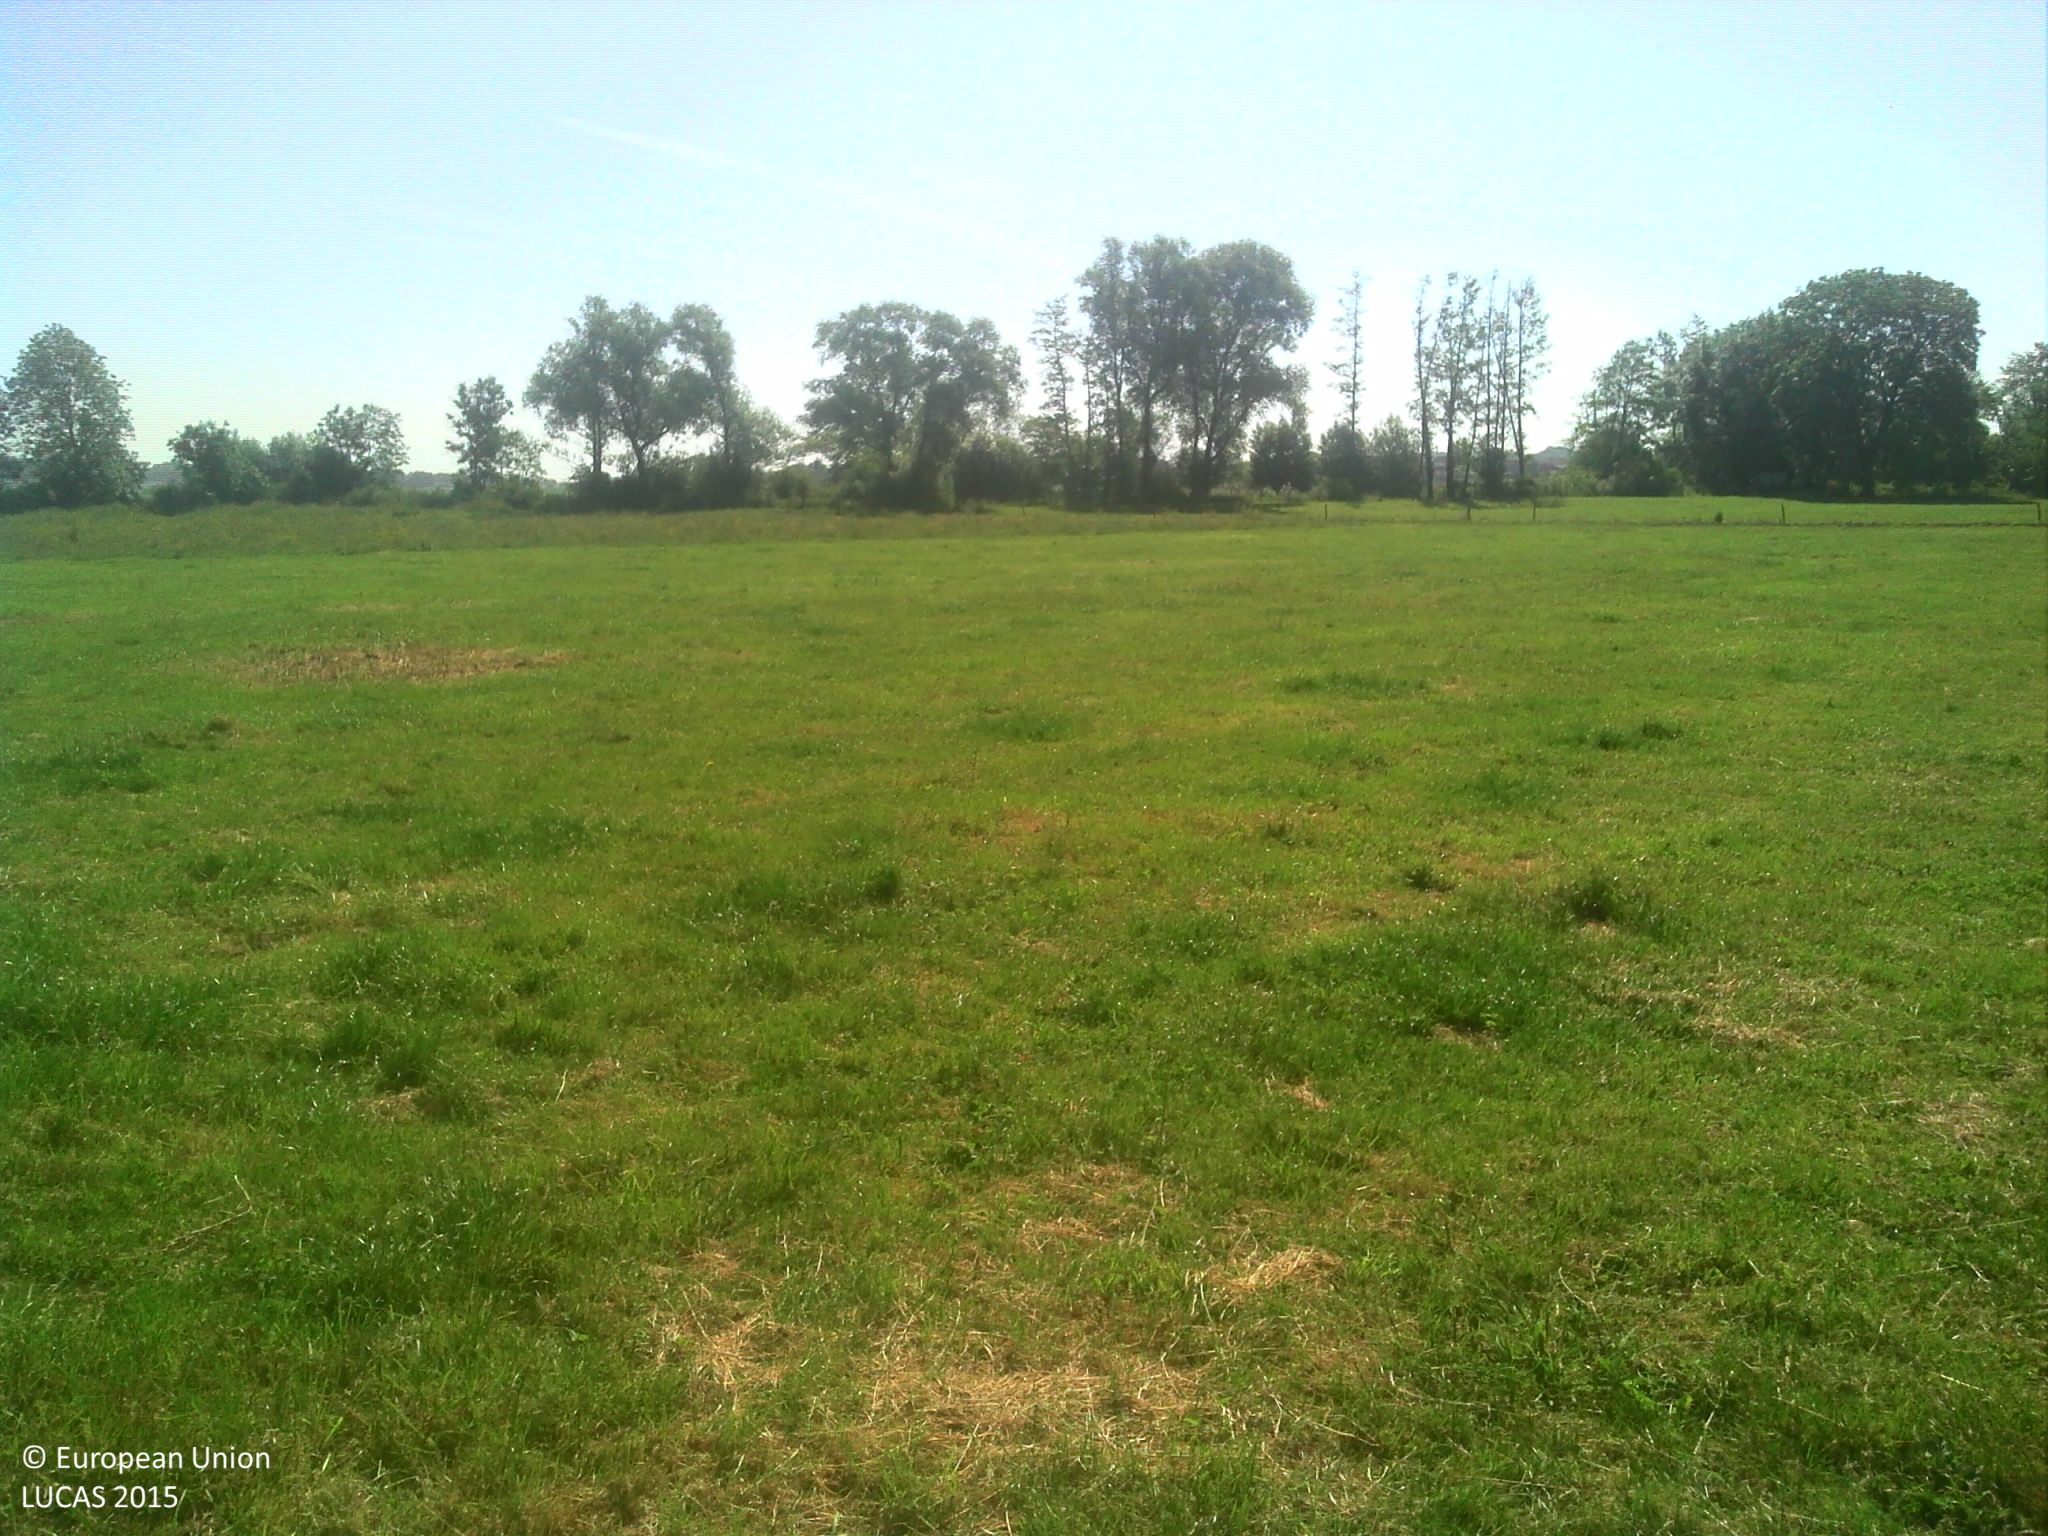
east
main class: Grassland
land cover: Grassland without tree/shrub cover
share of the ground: > 75 %
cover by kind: herbaceous plants 100 %
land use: Agriculture (excluding fallow land and kitchen gardens)
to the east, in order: Grassland without tree/shrub cover; Fences; Grassland without tree/shrub cover; Fences; Lines of trees; Rivers and streams; Lines of trees; Fences; Grassland without tree/shrub cover; Broadleaved woodland; Grassland without tree/shrub cover
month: June
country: FR
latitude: 48.4393
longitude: 4.7125
